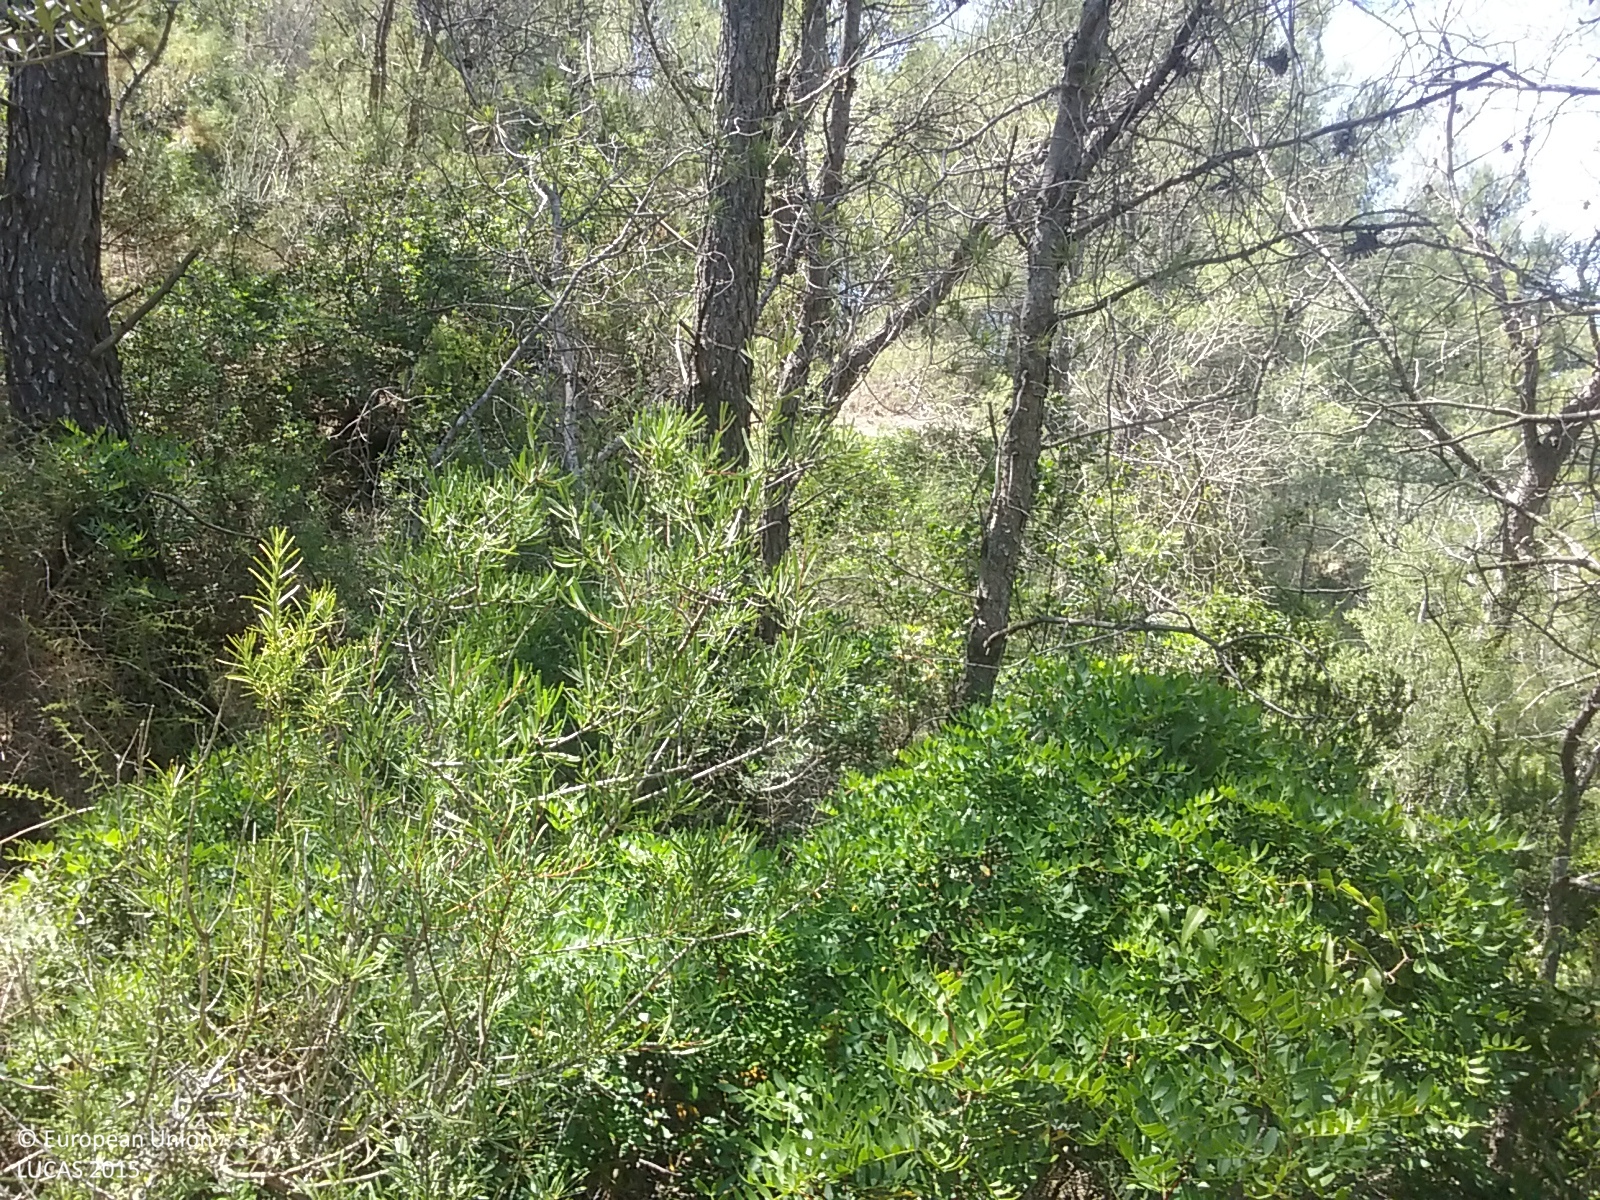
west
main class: Woodland
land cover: Pine dominated coniferous woodland
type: coniferous forest of the mediterranean region
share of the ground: > 75 %
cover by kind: coniferous forest trees 75 %, shrubs 20 %, herbaceous plants 5 %
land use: Semi-natural and natural areas not in use
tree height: > 5 m
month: June
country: ES
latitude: 40.9969
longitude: 0.5892
